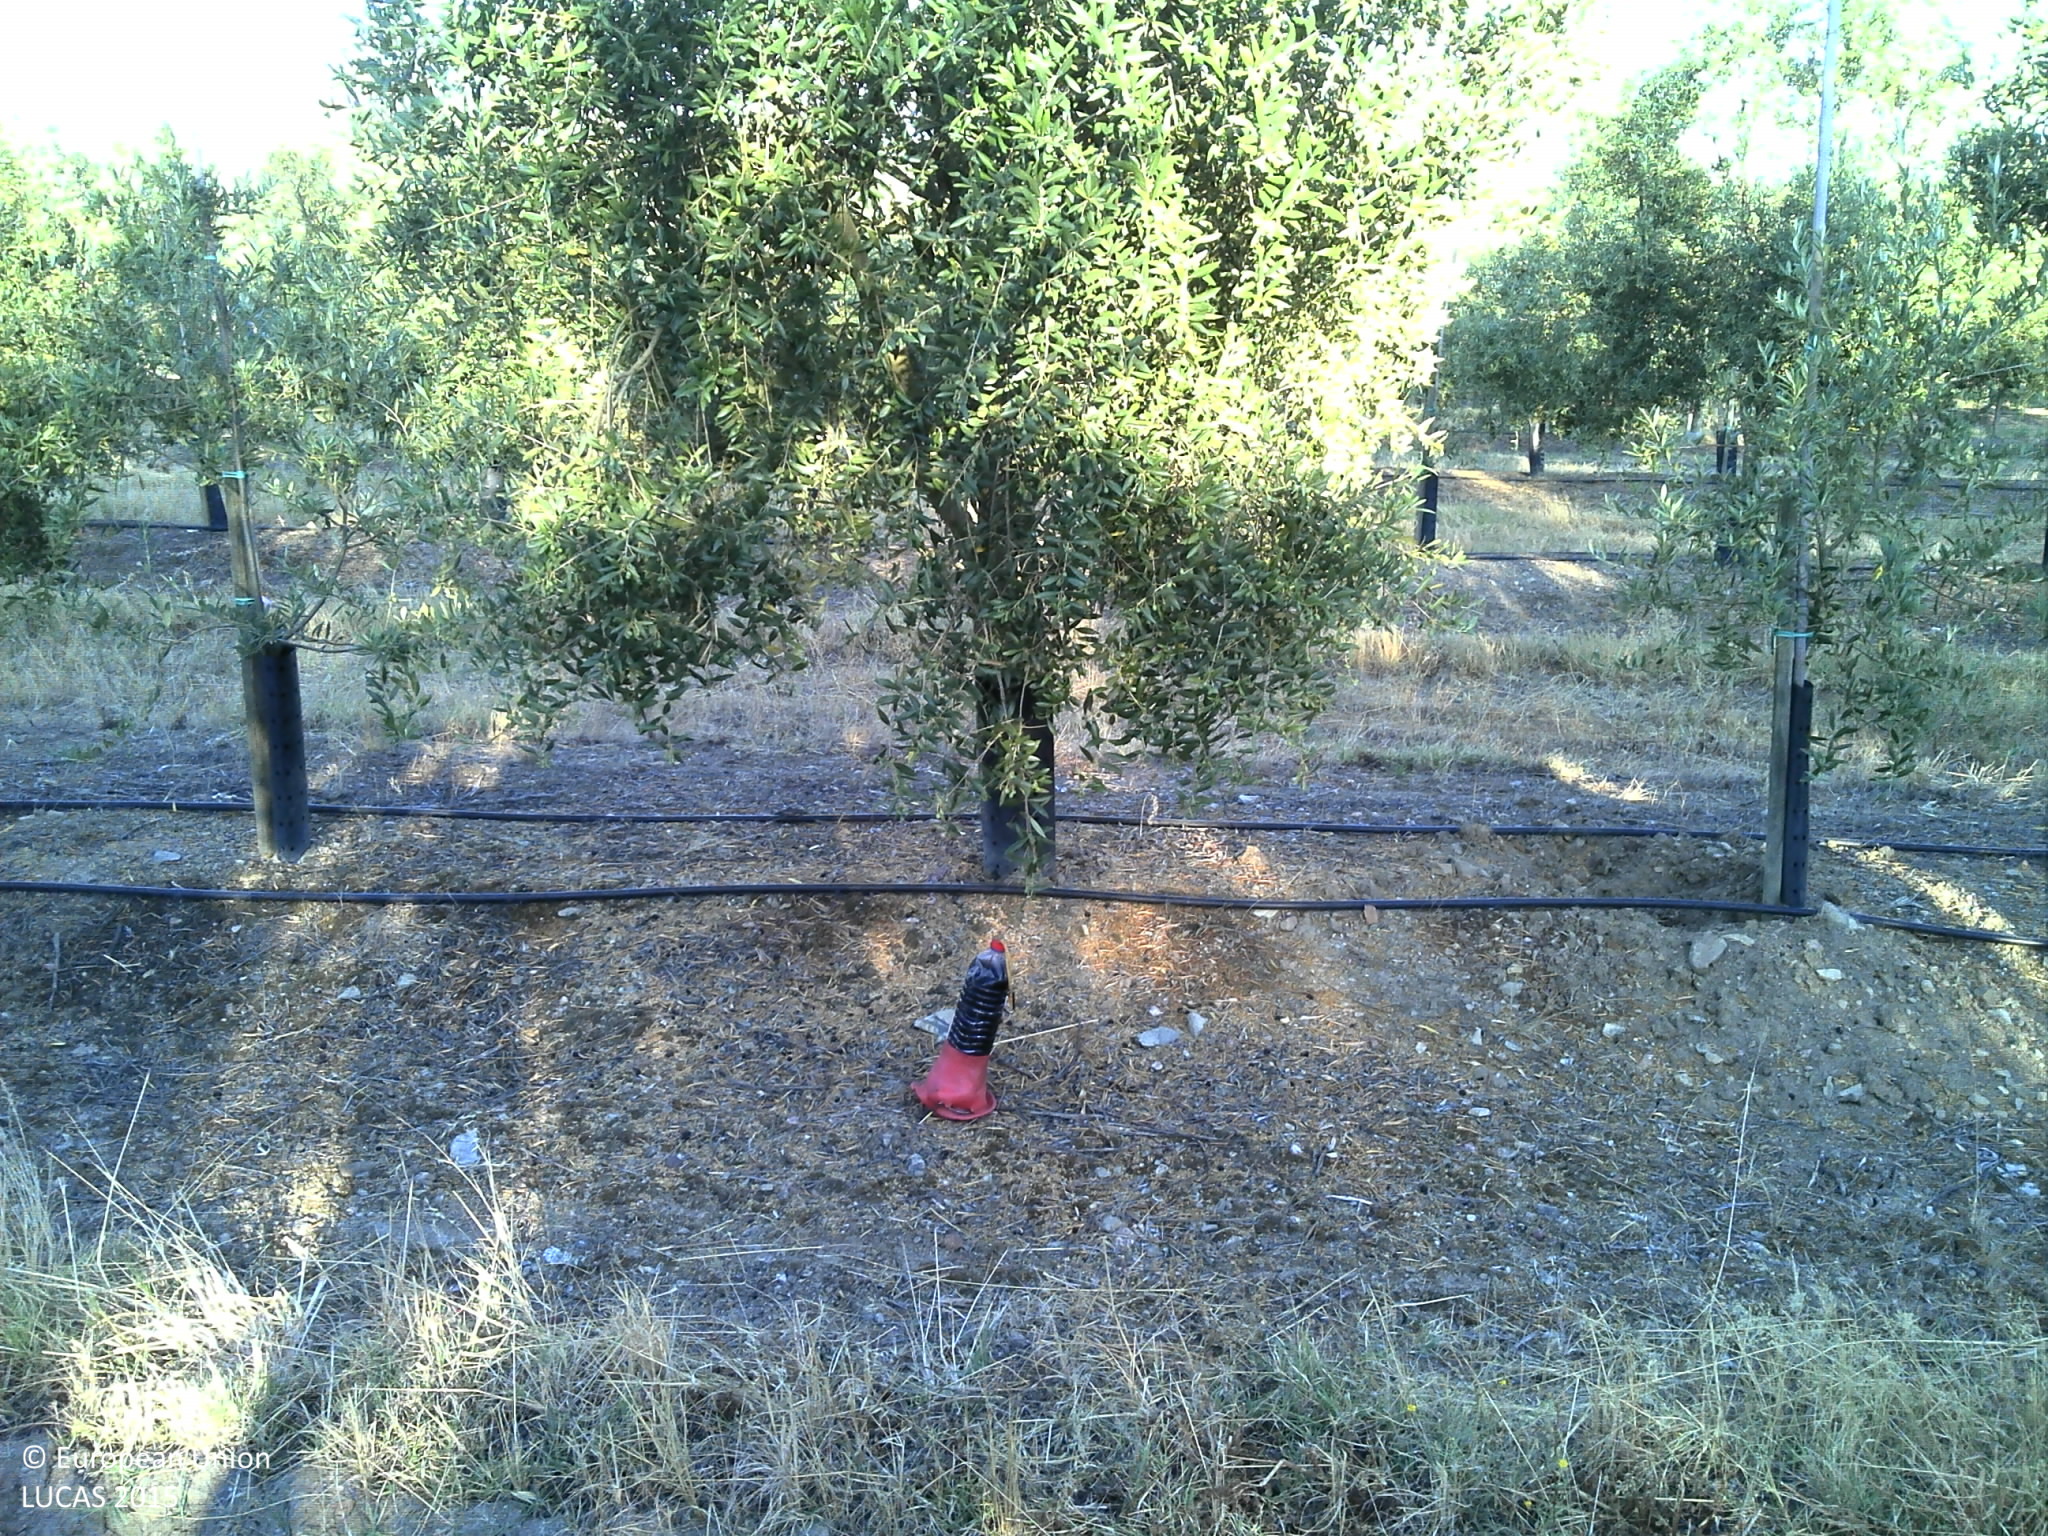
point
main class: Cropland
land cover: Olive groves
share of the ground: 25 - 50 %
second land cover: Spontaneously vegetated surfaces
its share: 10 - 25 %
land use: Agriculture (excluding fallow land and kitchen gardens)
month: June
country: PT
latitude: 38.1604
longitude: -8.1029
